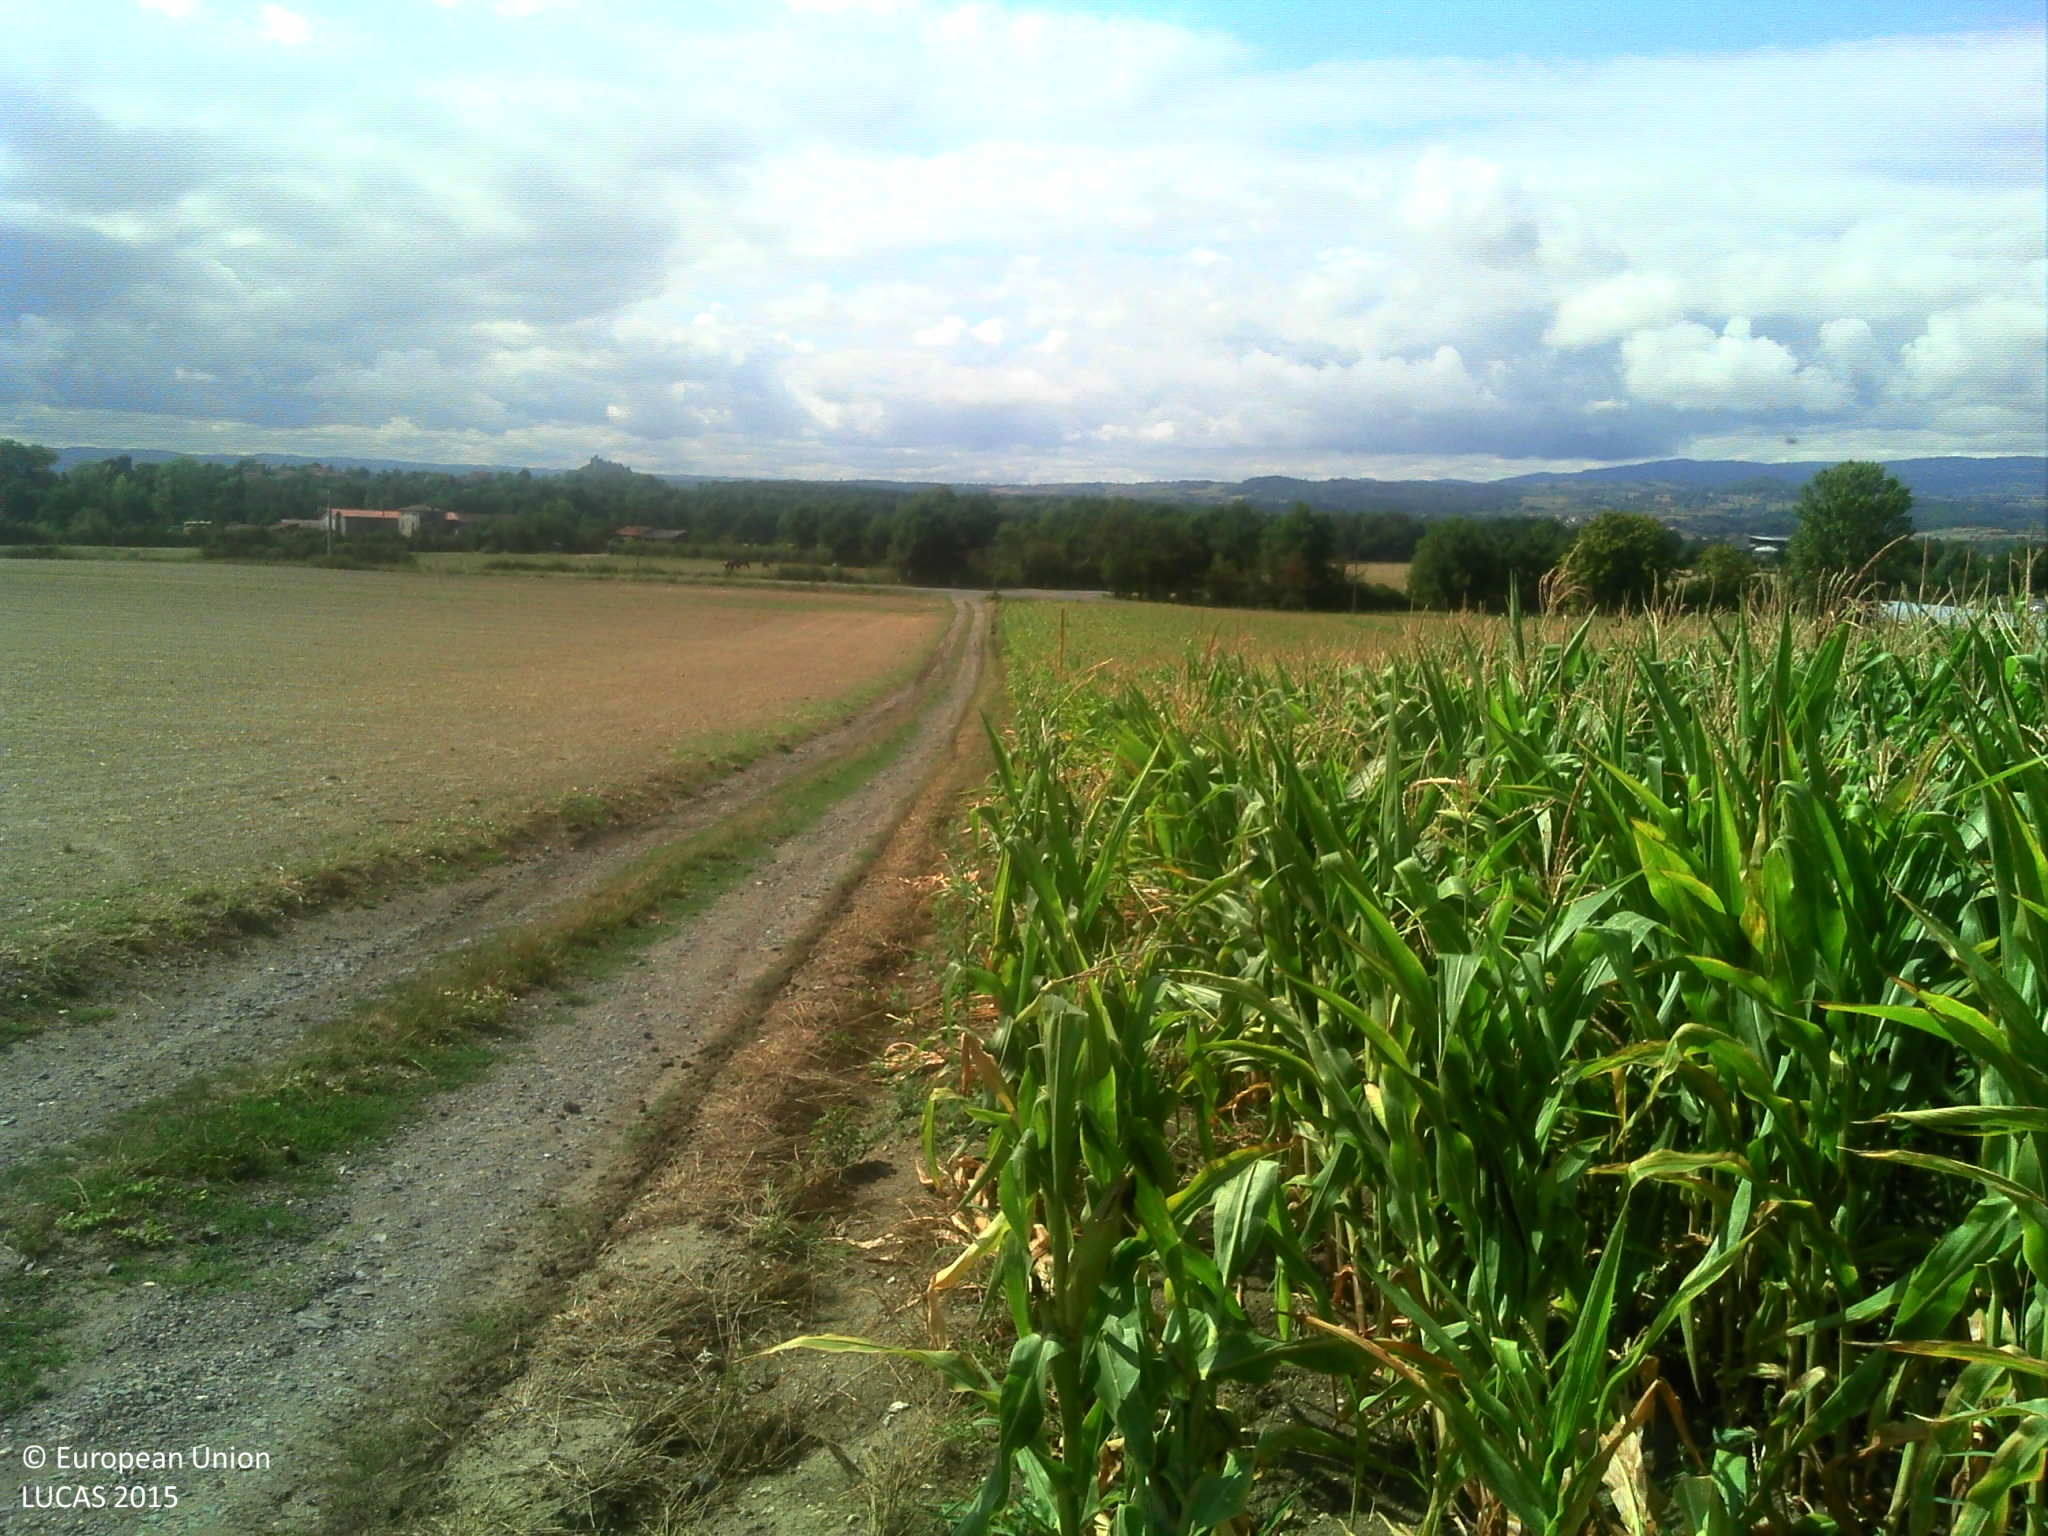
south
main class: Cropland
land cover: Maize
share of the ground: > 75 %
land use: Agriculture (excluding fallow land and kitchen gardens)
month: August
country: FR
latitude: 45.5934
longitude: 4.1191
